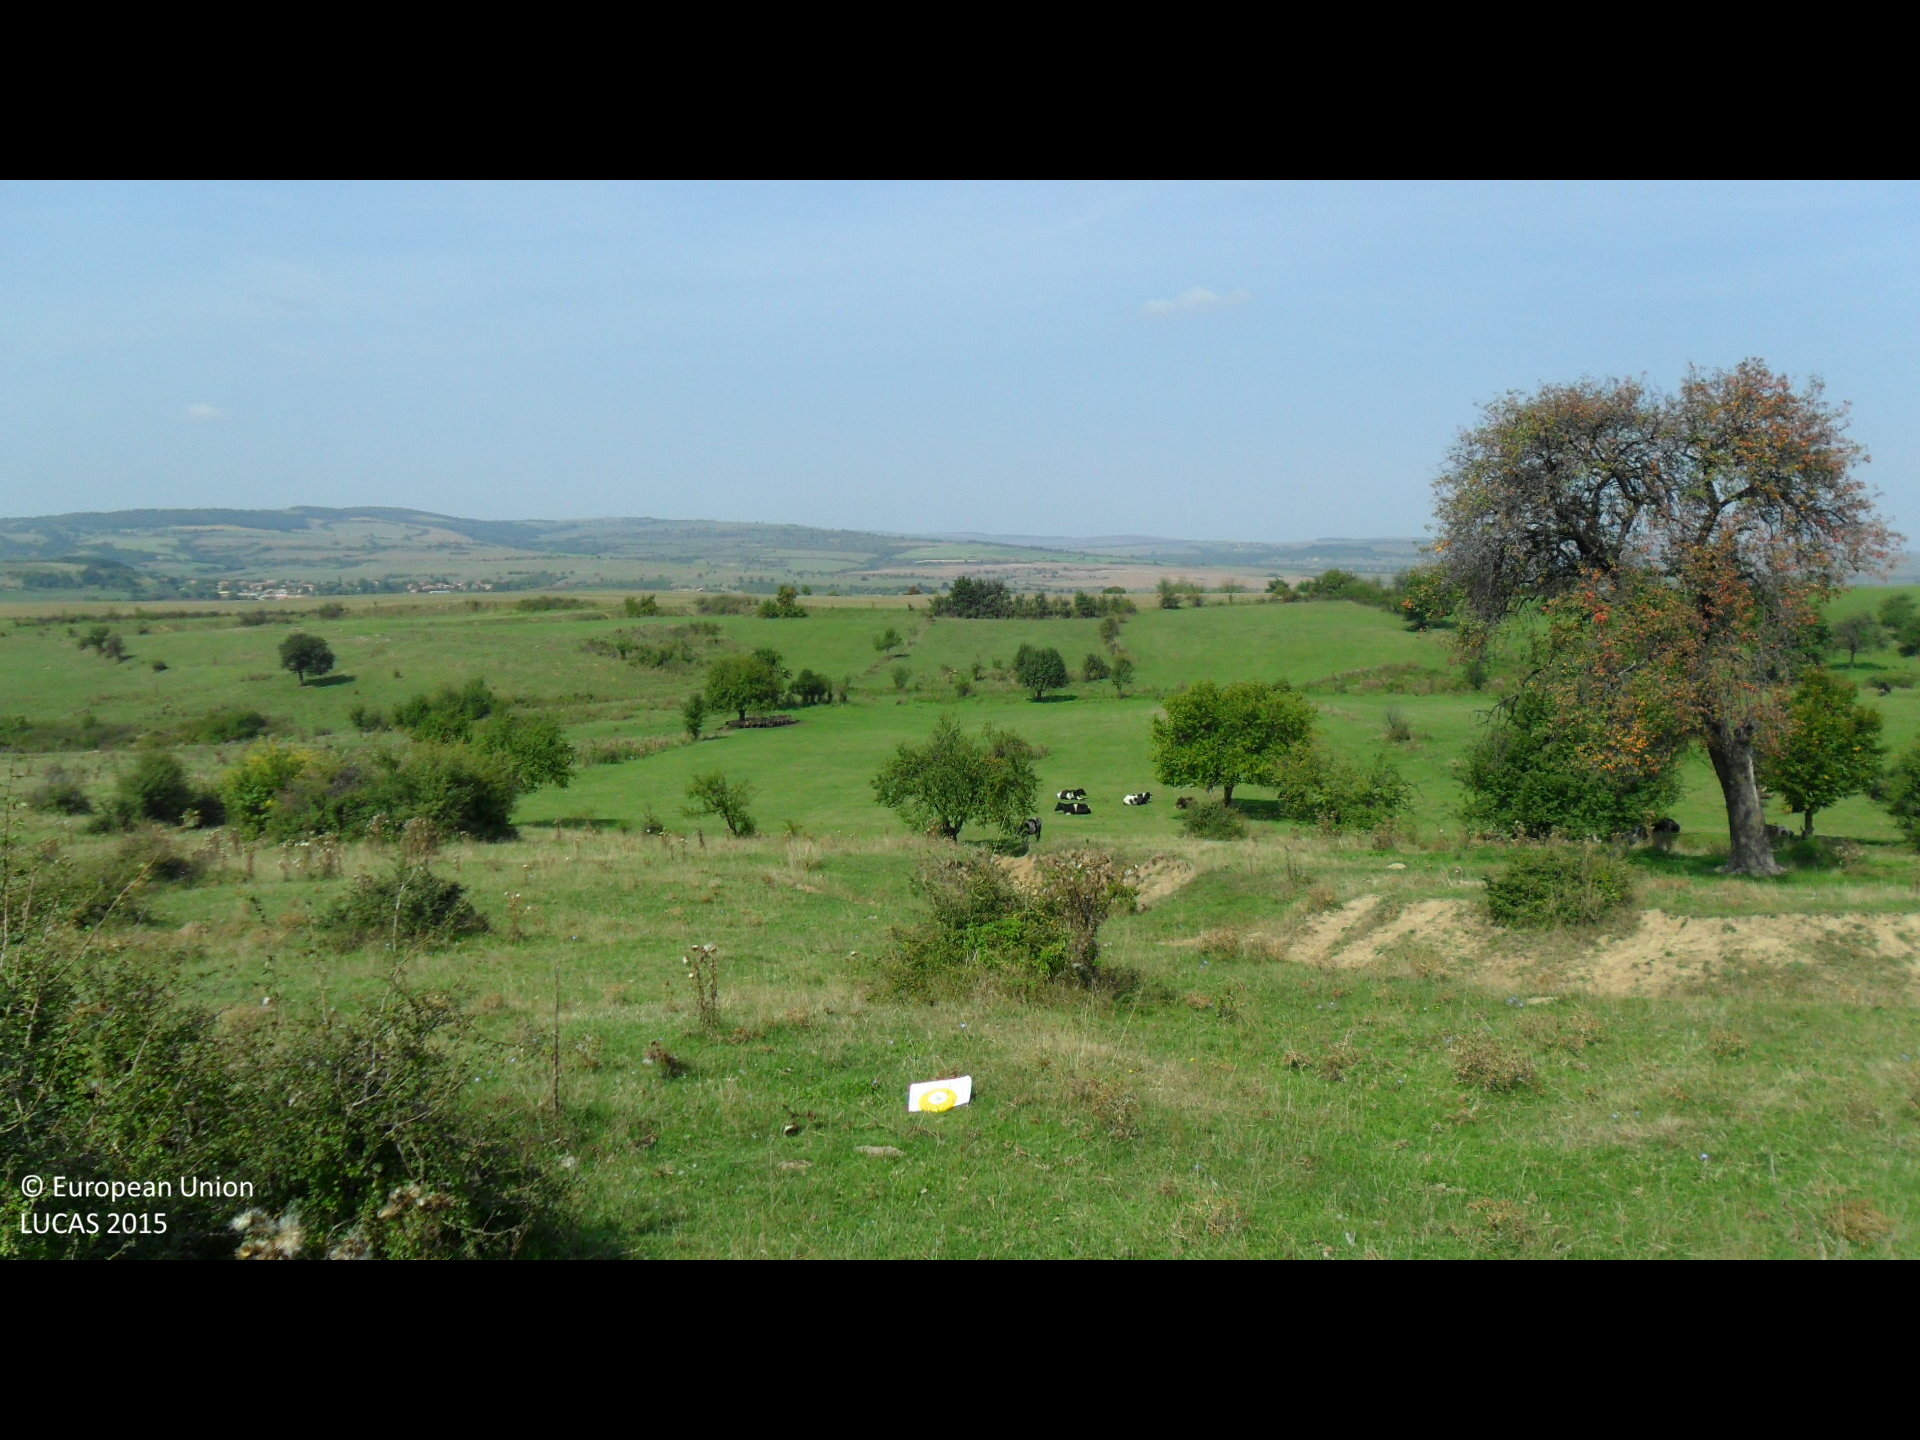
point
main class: Grassland
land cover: Grassland with sparse tree/shrub cover
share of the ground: > 75 %
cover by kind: herbaceous plants 90 %, broadleaved forest trees 5 %, shrubs 5 %
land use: Agriculture (excluding fallow land and kitchen gardens)
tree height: < 5 m
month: September
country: BG
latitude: 43.0100
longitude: 26.5524
